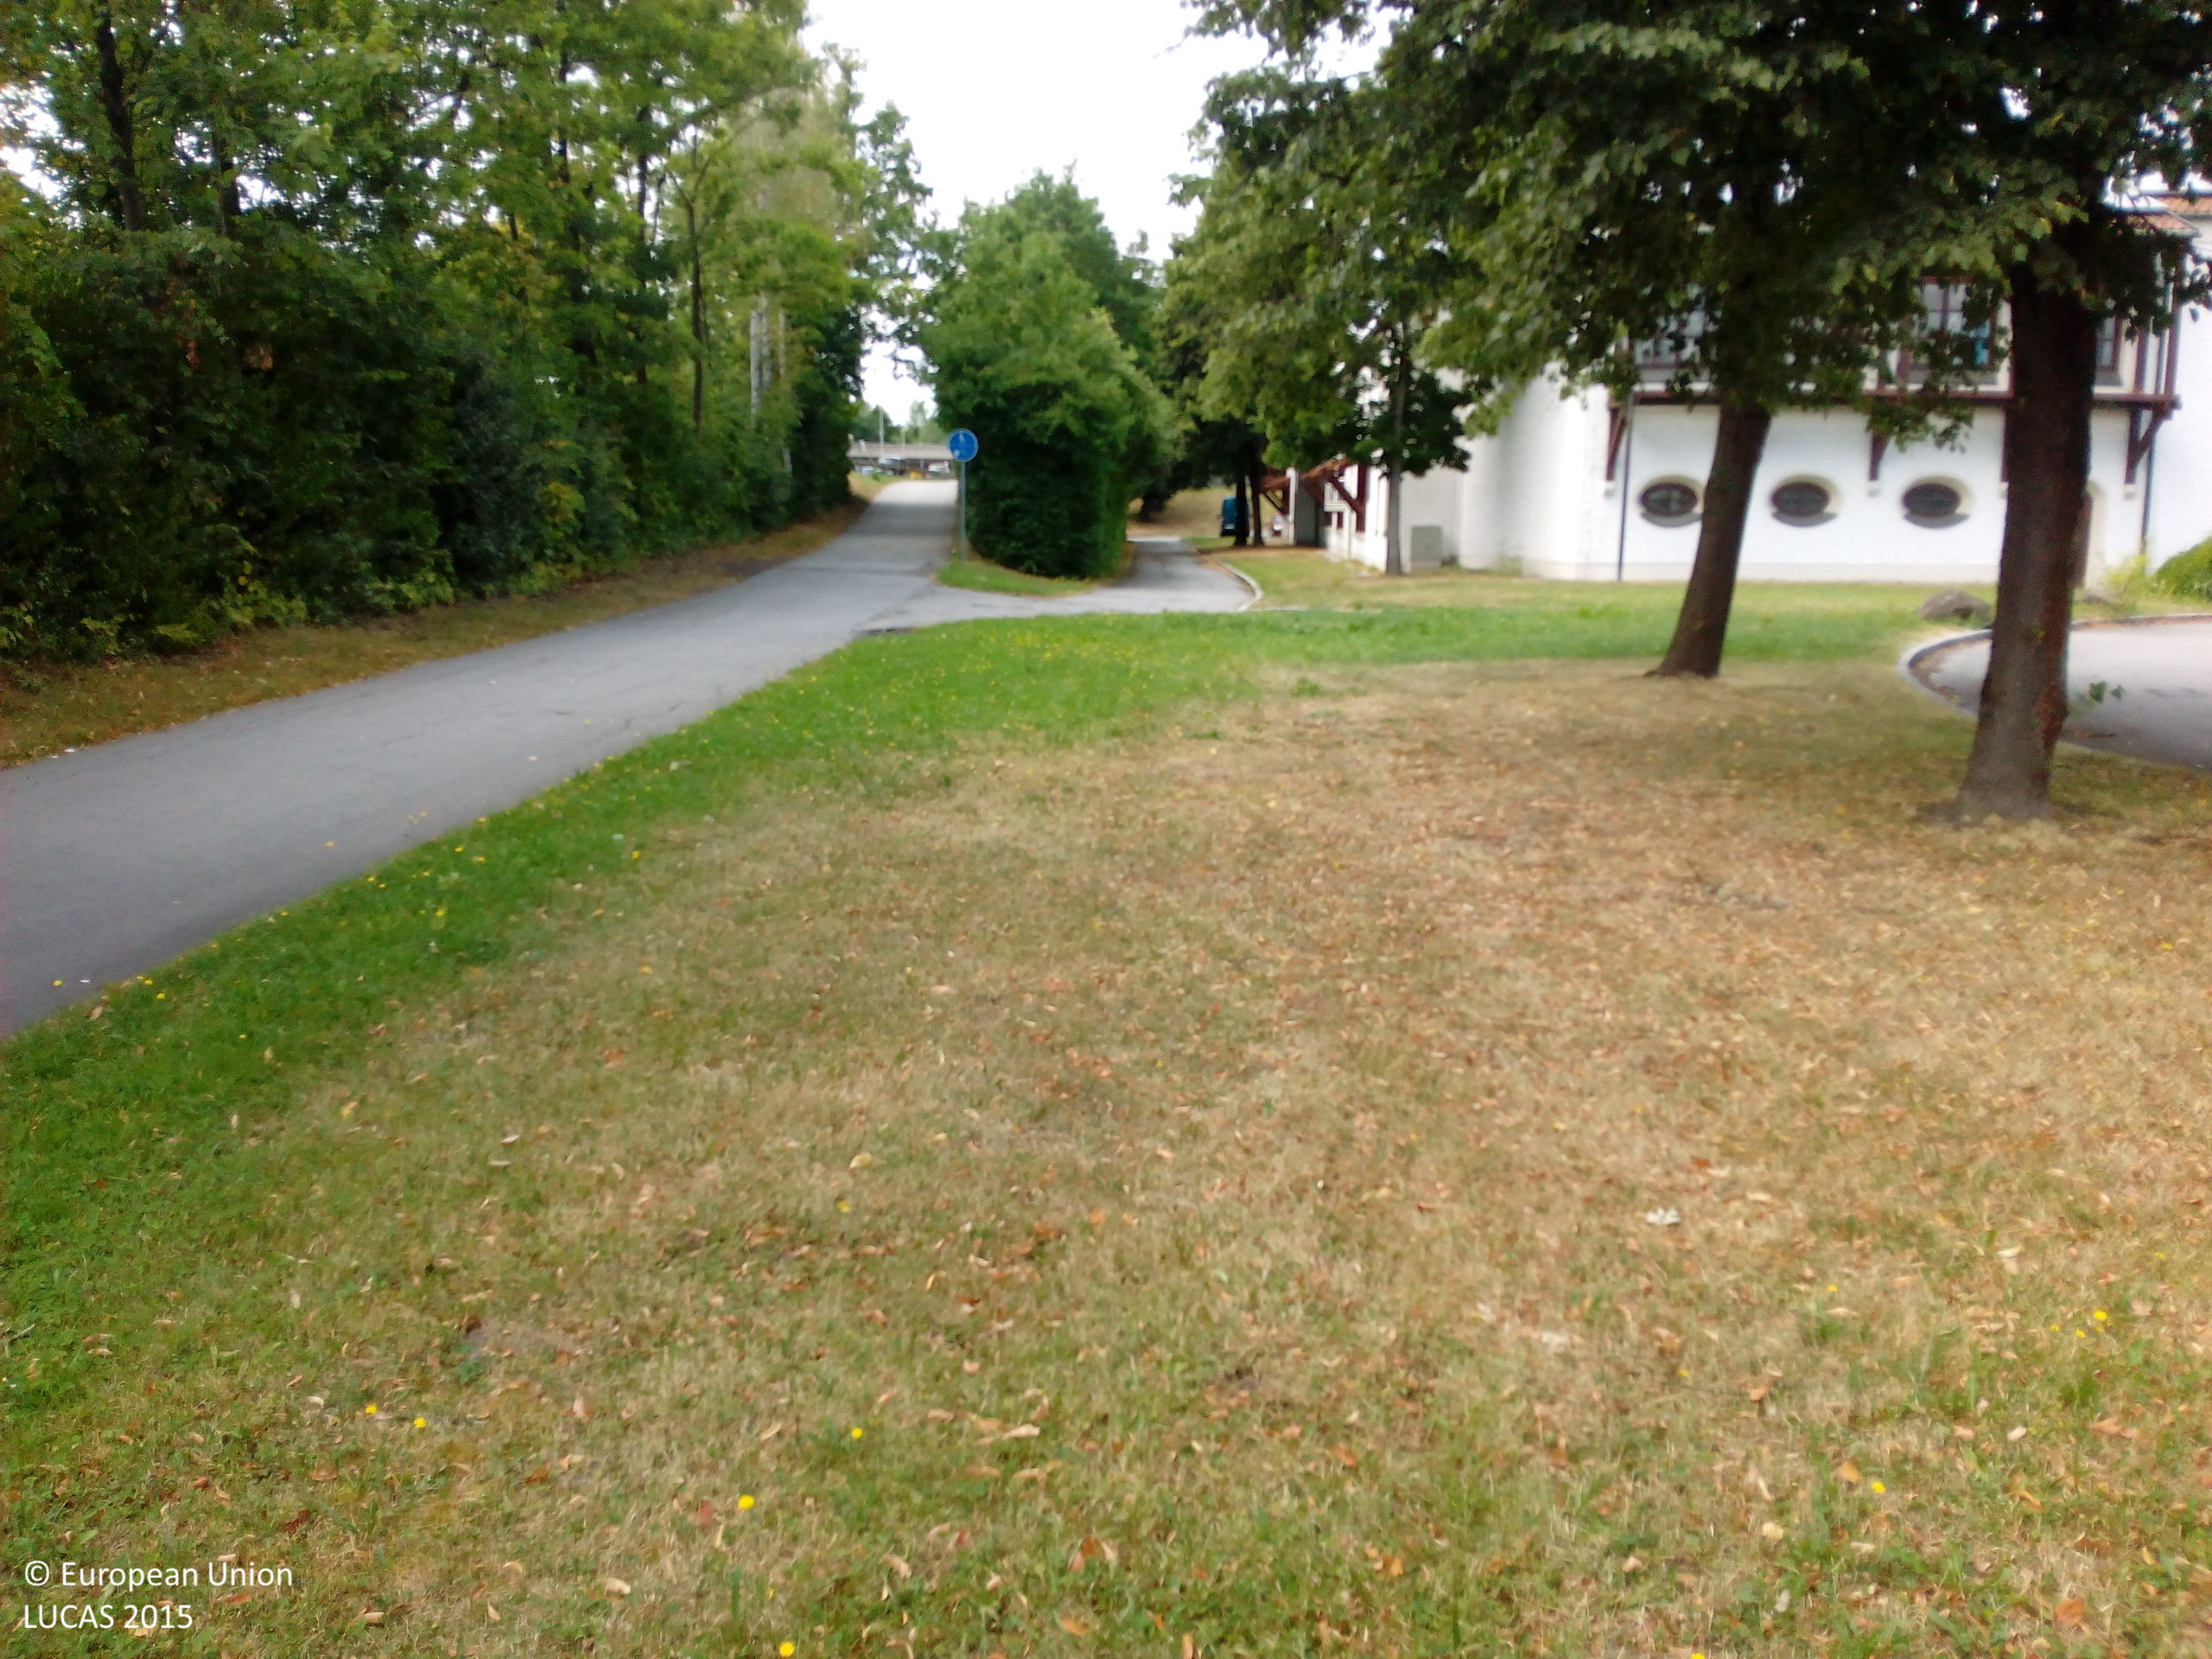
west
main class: Grassland
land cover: Grassland with sparse tree/shrub cover
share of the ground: > 75 %
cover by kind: herbaceous plants 95 %, broadleaved forest trees 5 %
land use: Community services
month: July
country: DE
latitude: 48.8321
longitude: 12.9557
